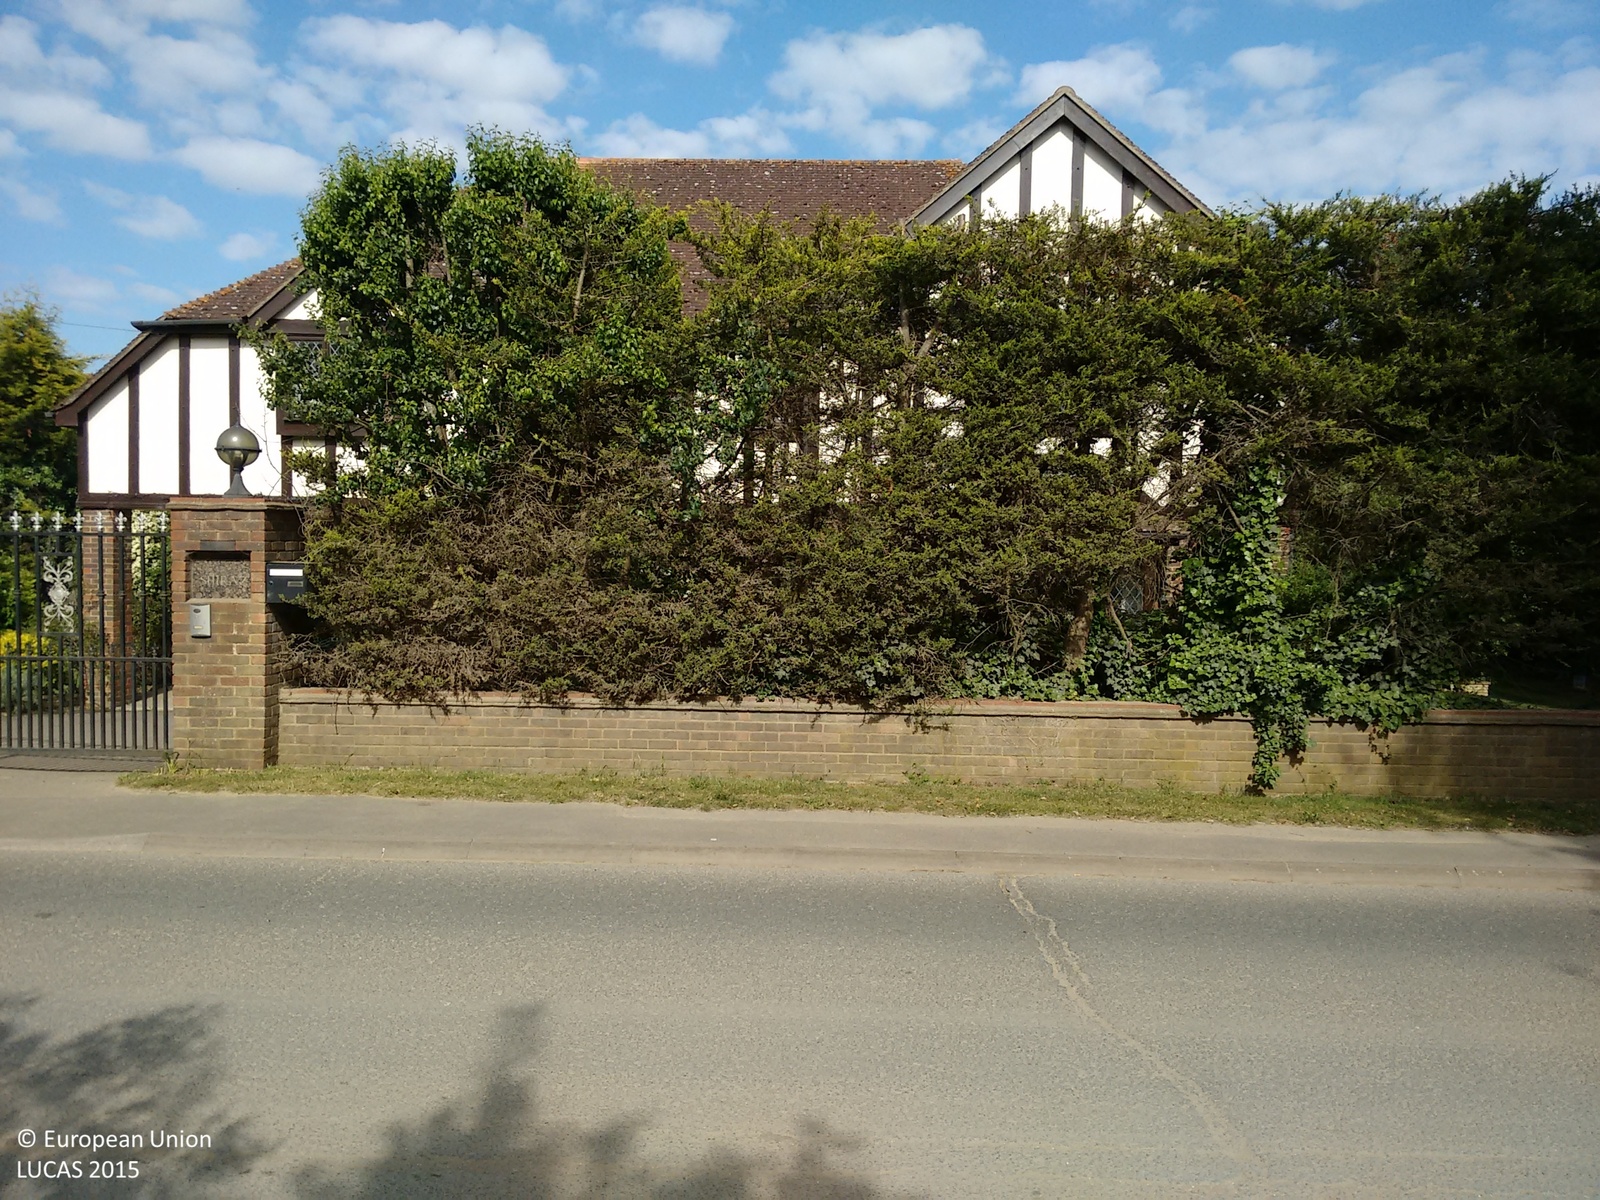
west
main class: Woodland
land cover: Broadleaved woodland
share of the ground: > 75 %
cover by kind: broadleaved forest trees 80 %, shrubs 10 %, herbaceous plants 10 %
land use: Semi-natural and natural areas not in use
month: June
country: GB
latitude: 51.4947
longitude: -0.6850
